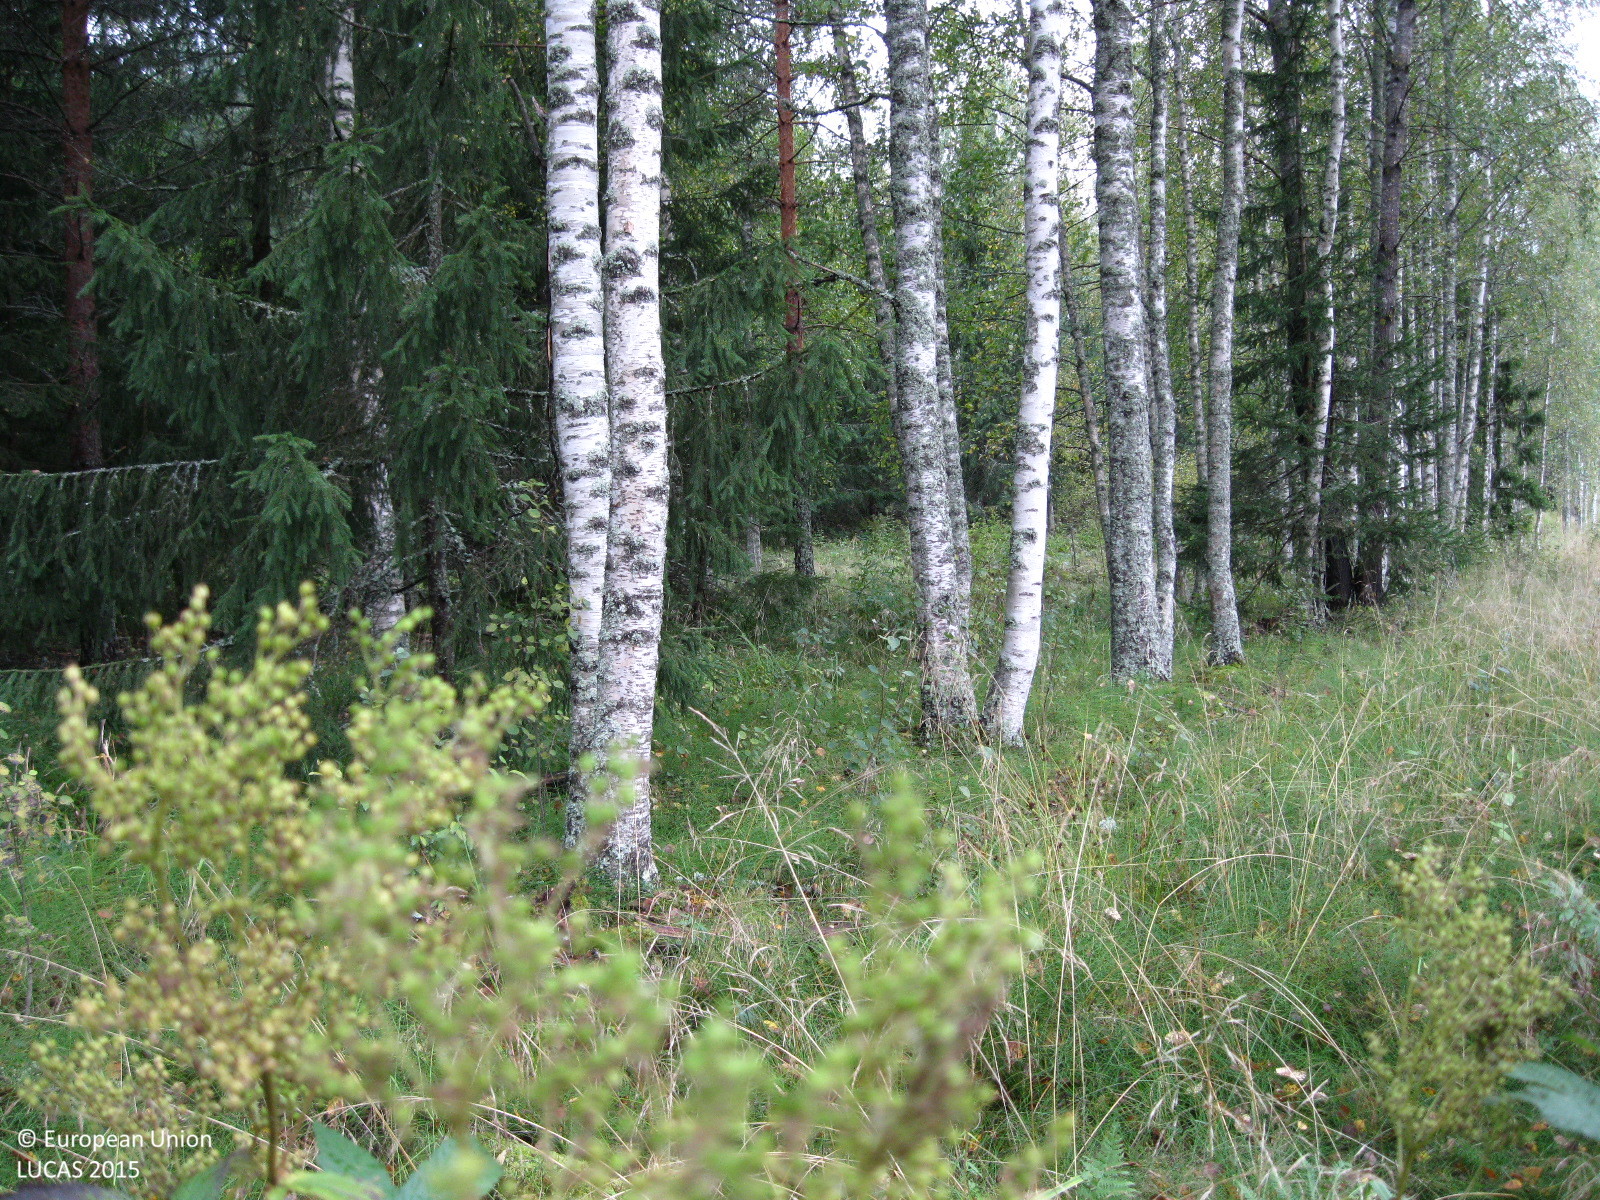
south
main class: Woodland
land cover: Broadleaved woodland
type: boreal forest
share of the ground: 50 - 75 %
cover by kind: broadleaved forest trees 50 %, herbaceous plants 45 %, coniferous forest trees 5 %
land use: Forestry
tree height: > 5 m
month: September
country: FI
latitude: 60.4752
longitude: 24.6447
